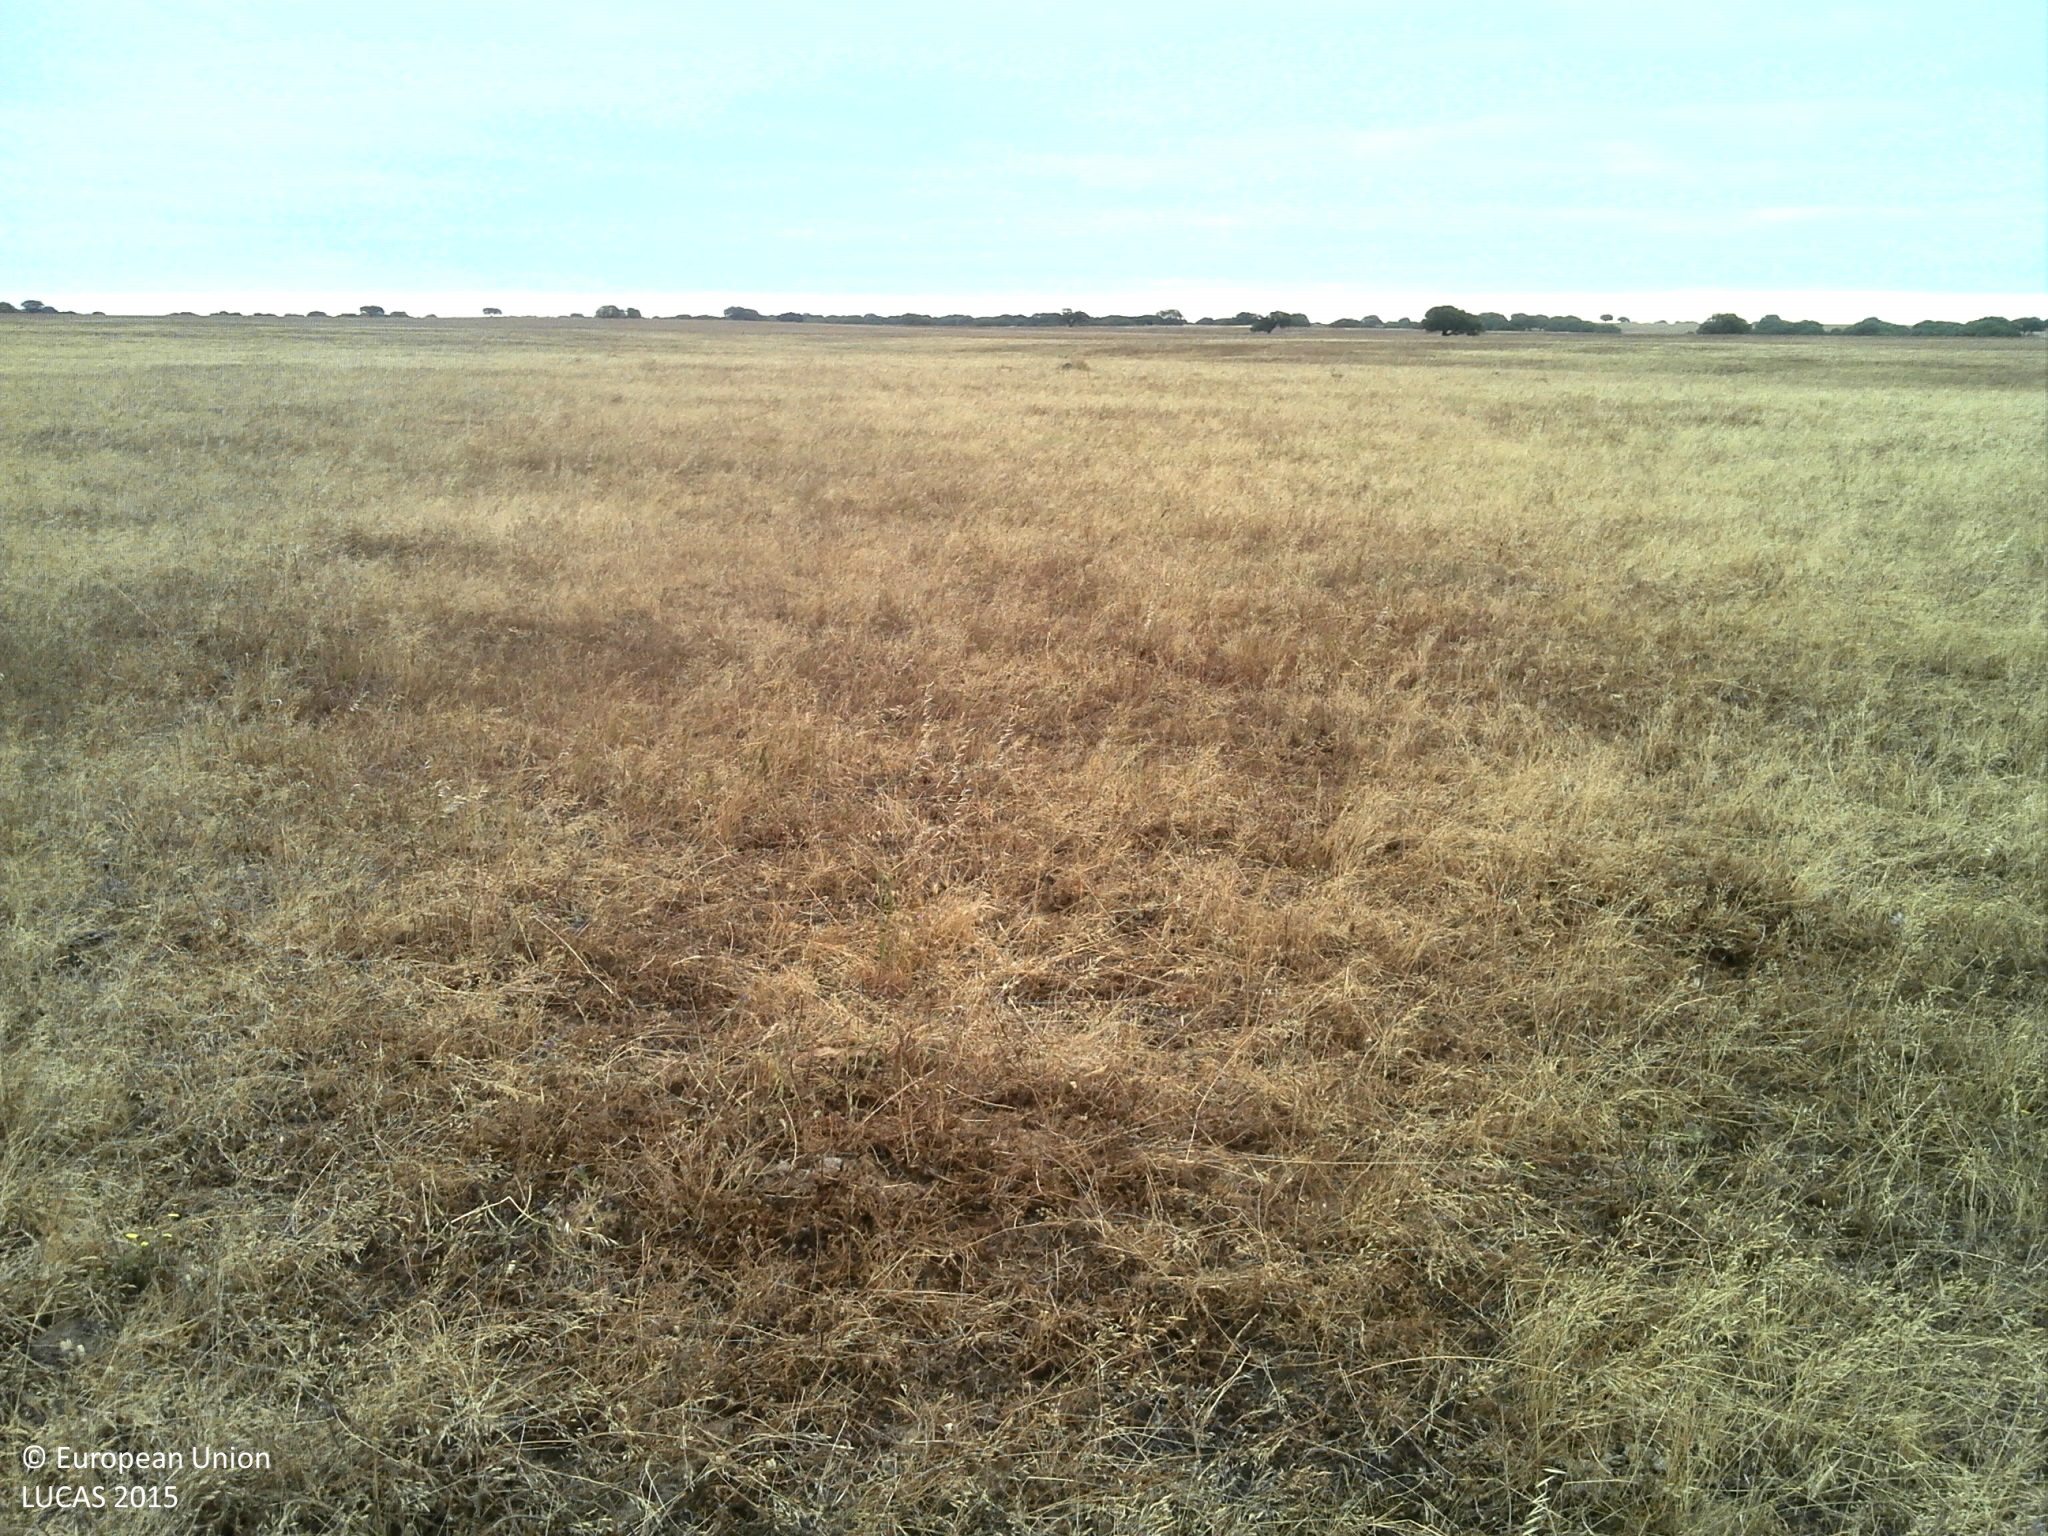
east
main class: Grassland
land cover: Grassland without tree/shrub cover
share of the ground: 50 - 75 %
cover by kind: herbaceous plants 70 %, unconsolidated bare surface 30 %
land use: Agriculture (excluding fallow land and kitchen gardens)
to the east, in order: Grassland without tree/shrub cover
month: June
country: PT
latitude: 37.9991
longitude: -8.3625
